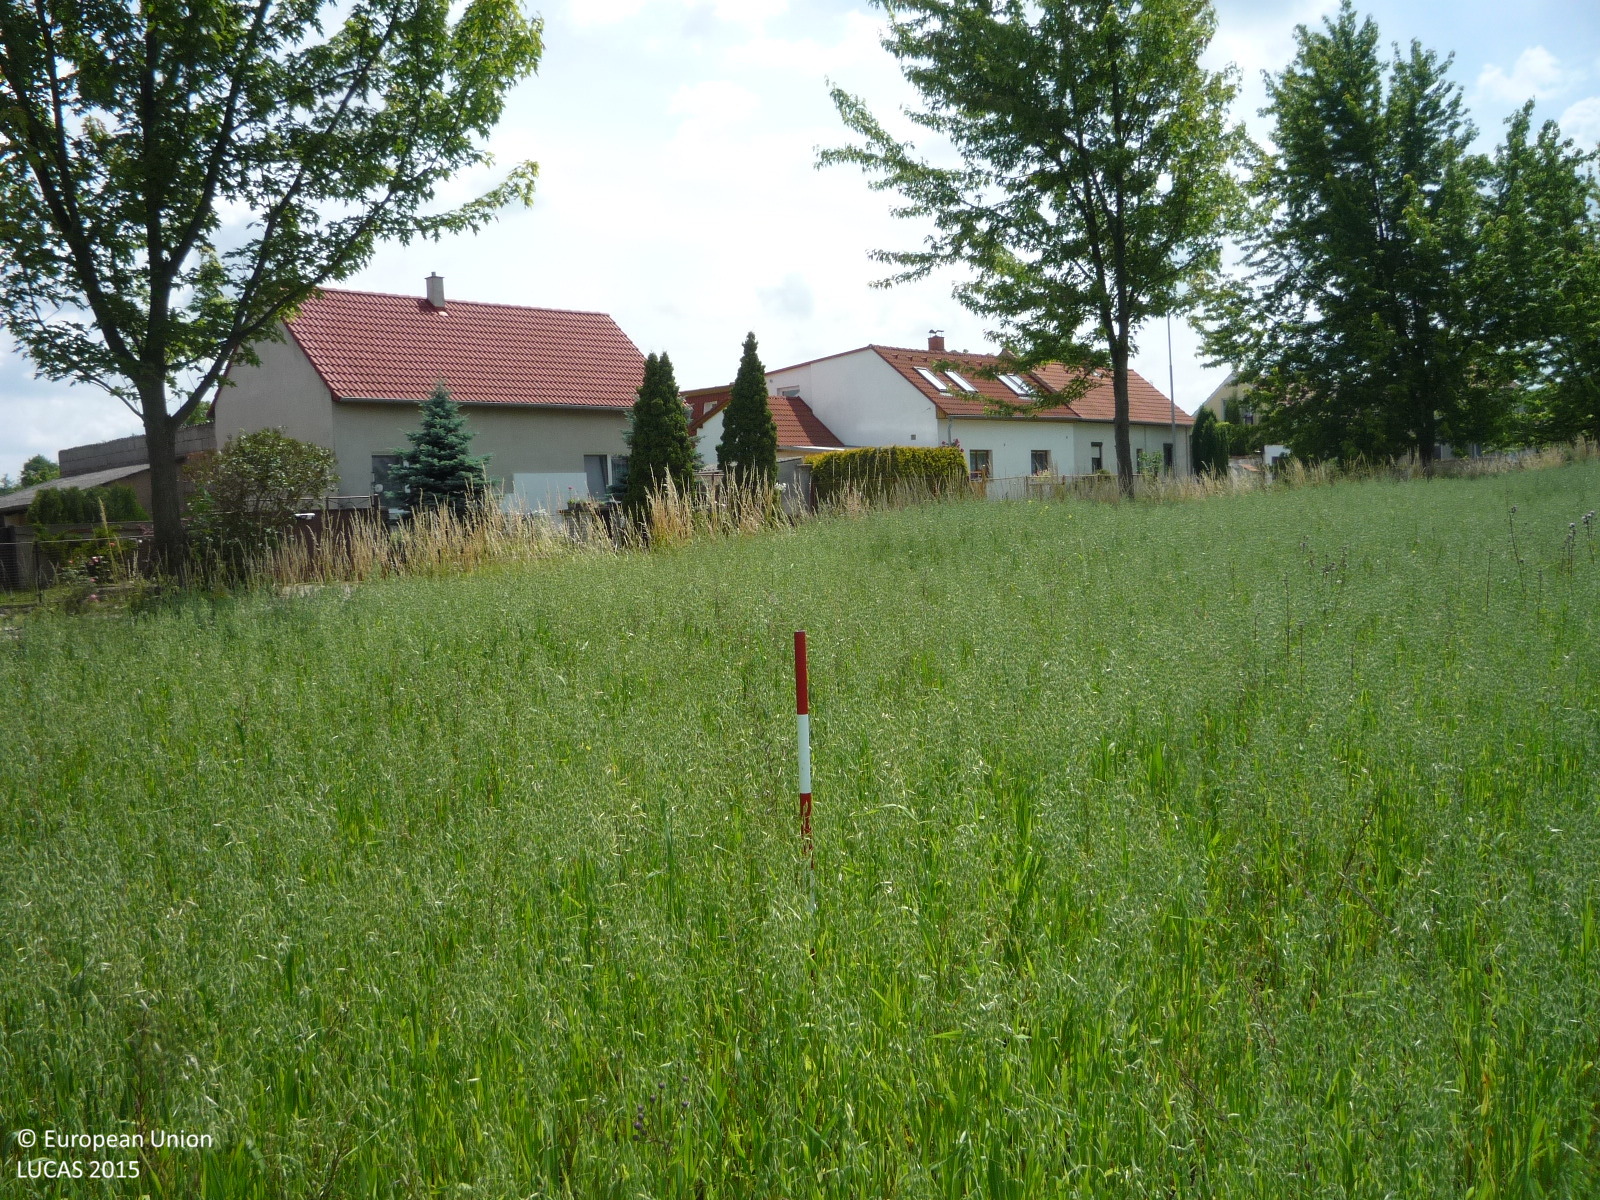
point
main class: Cropland
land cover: Oats
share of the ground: > 75 %
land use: Agriculture (excluding fallow land and kitchen gardens)
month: June
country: CZ
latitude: 50.3978
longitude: 14.1230
